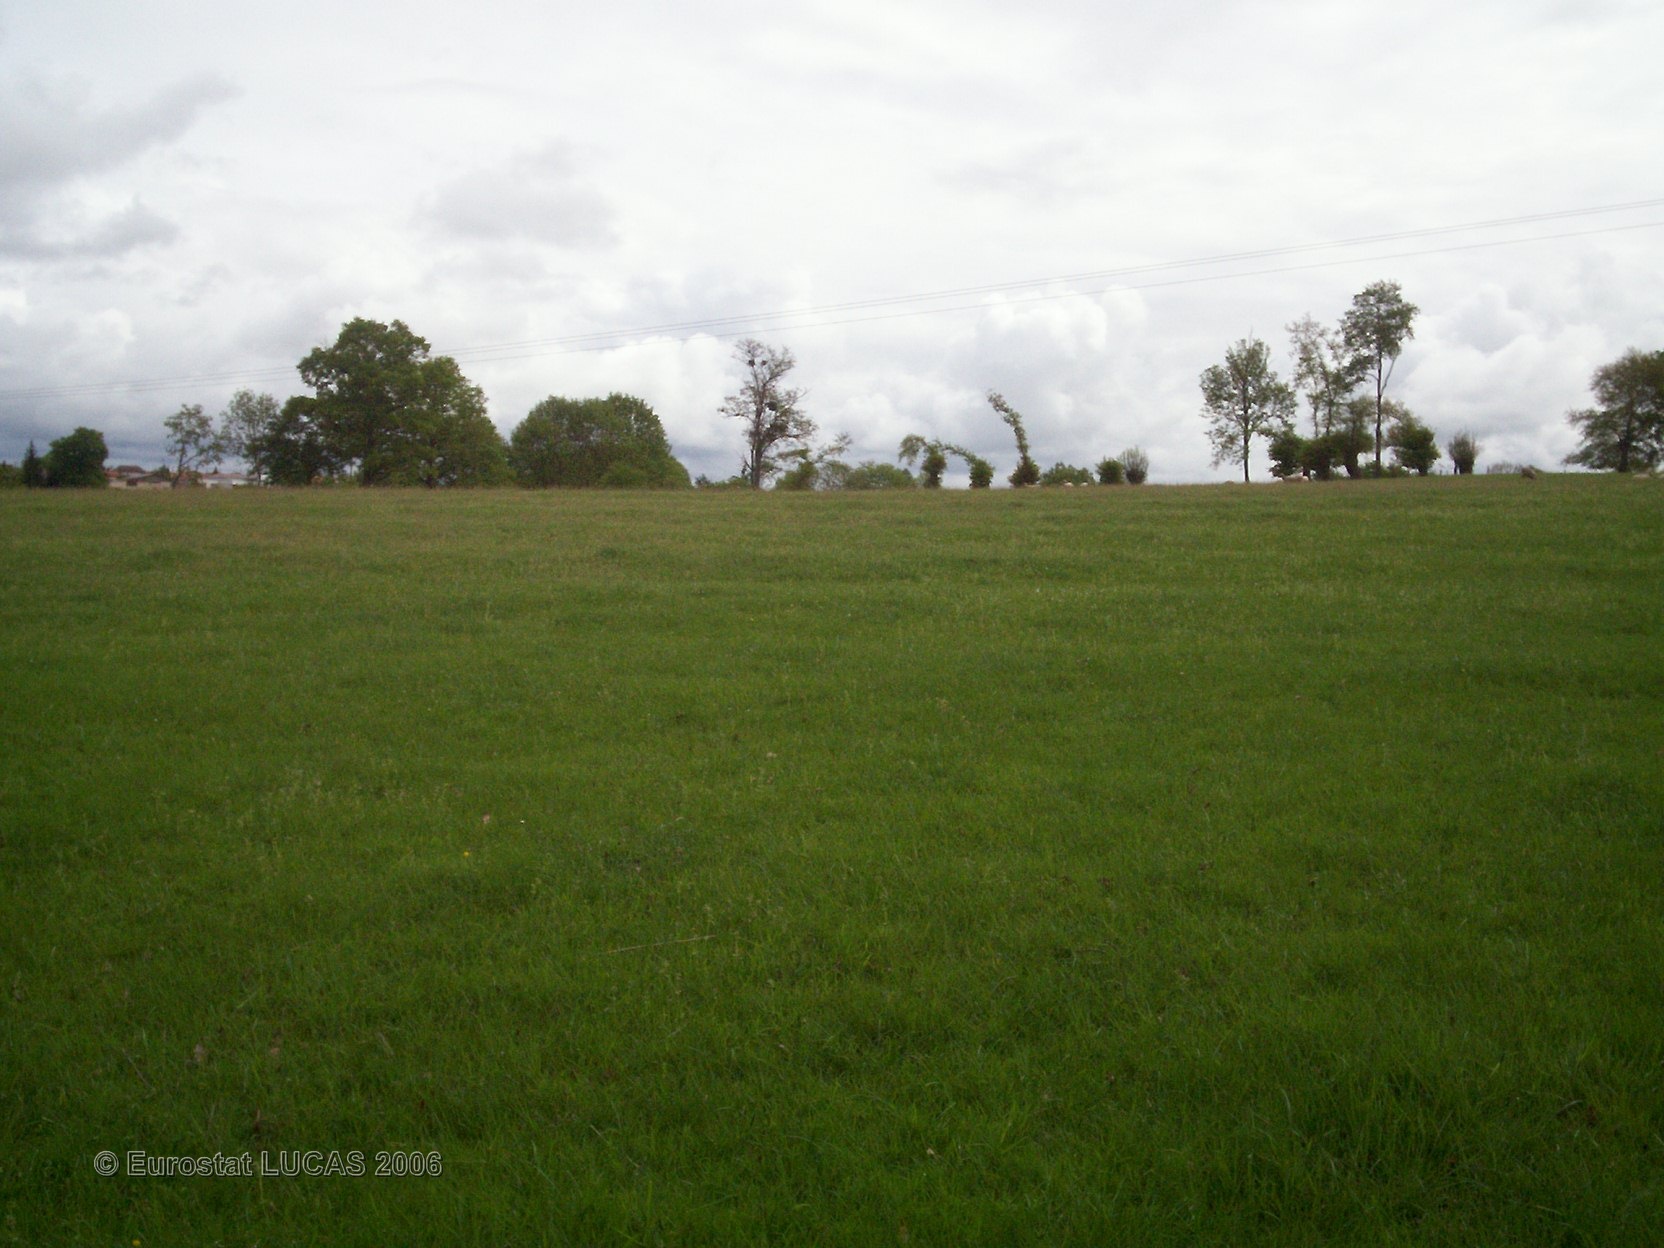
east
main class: Grassland
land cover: Grassland without tree/shrub cover
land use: Agriculture (excluding fallow land and kitchen gardens)
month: May
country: FR
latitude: 46.6351
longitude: -0.2791
